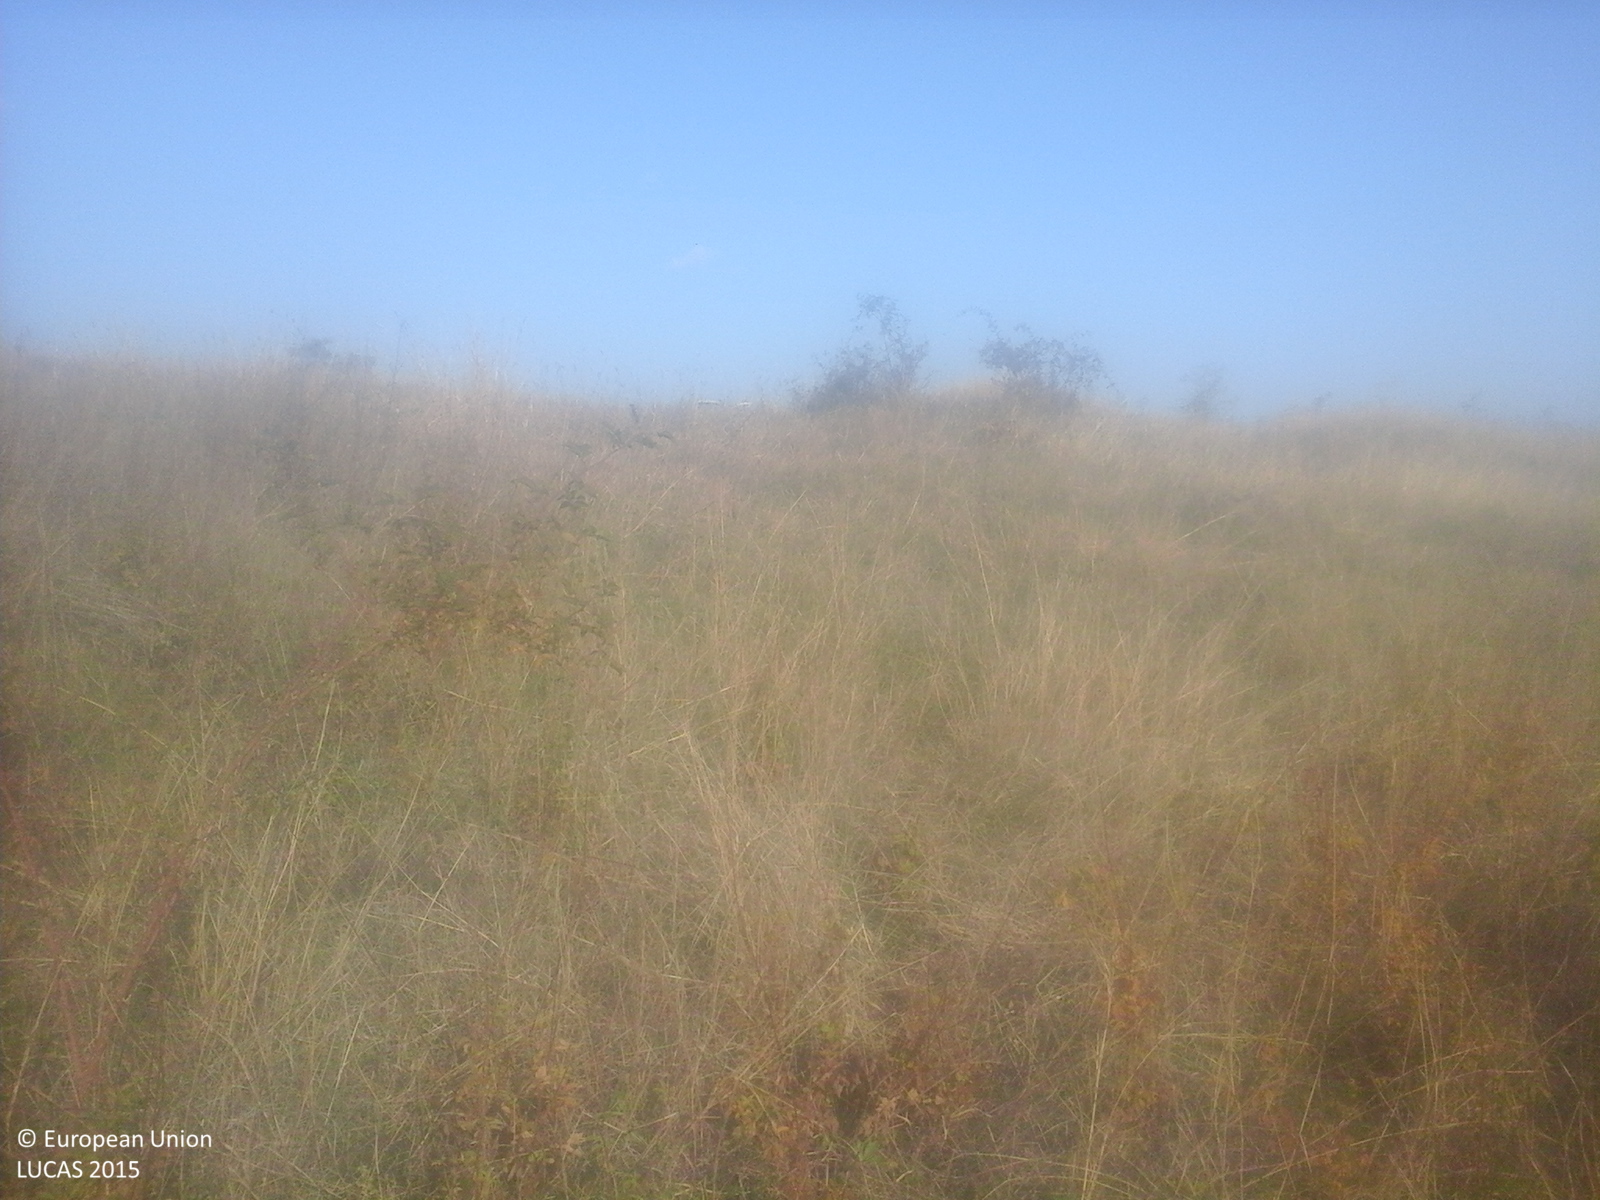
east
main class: Grassland
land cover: Grassland with sparse tree/shrub cover
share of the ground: > 75 %
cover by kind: herbaceous plants 85 %, shrubs 10 %, broadleaved forest trees 5 %
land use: Agriculture (excluding fallow land and kitchen gardens)
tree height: < 5 m
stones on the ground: < 10 %
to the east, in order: Grassland with sparse tree/shrub cover; Tracks; Grassland without tree/shrub cover; Tracks; Grassland without tree/shrub cover; Grassland with sparse tree/shrub cover
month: October
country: RO
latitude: 45.3312
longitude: 26.8614
